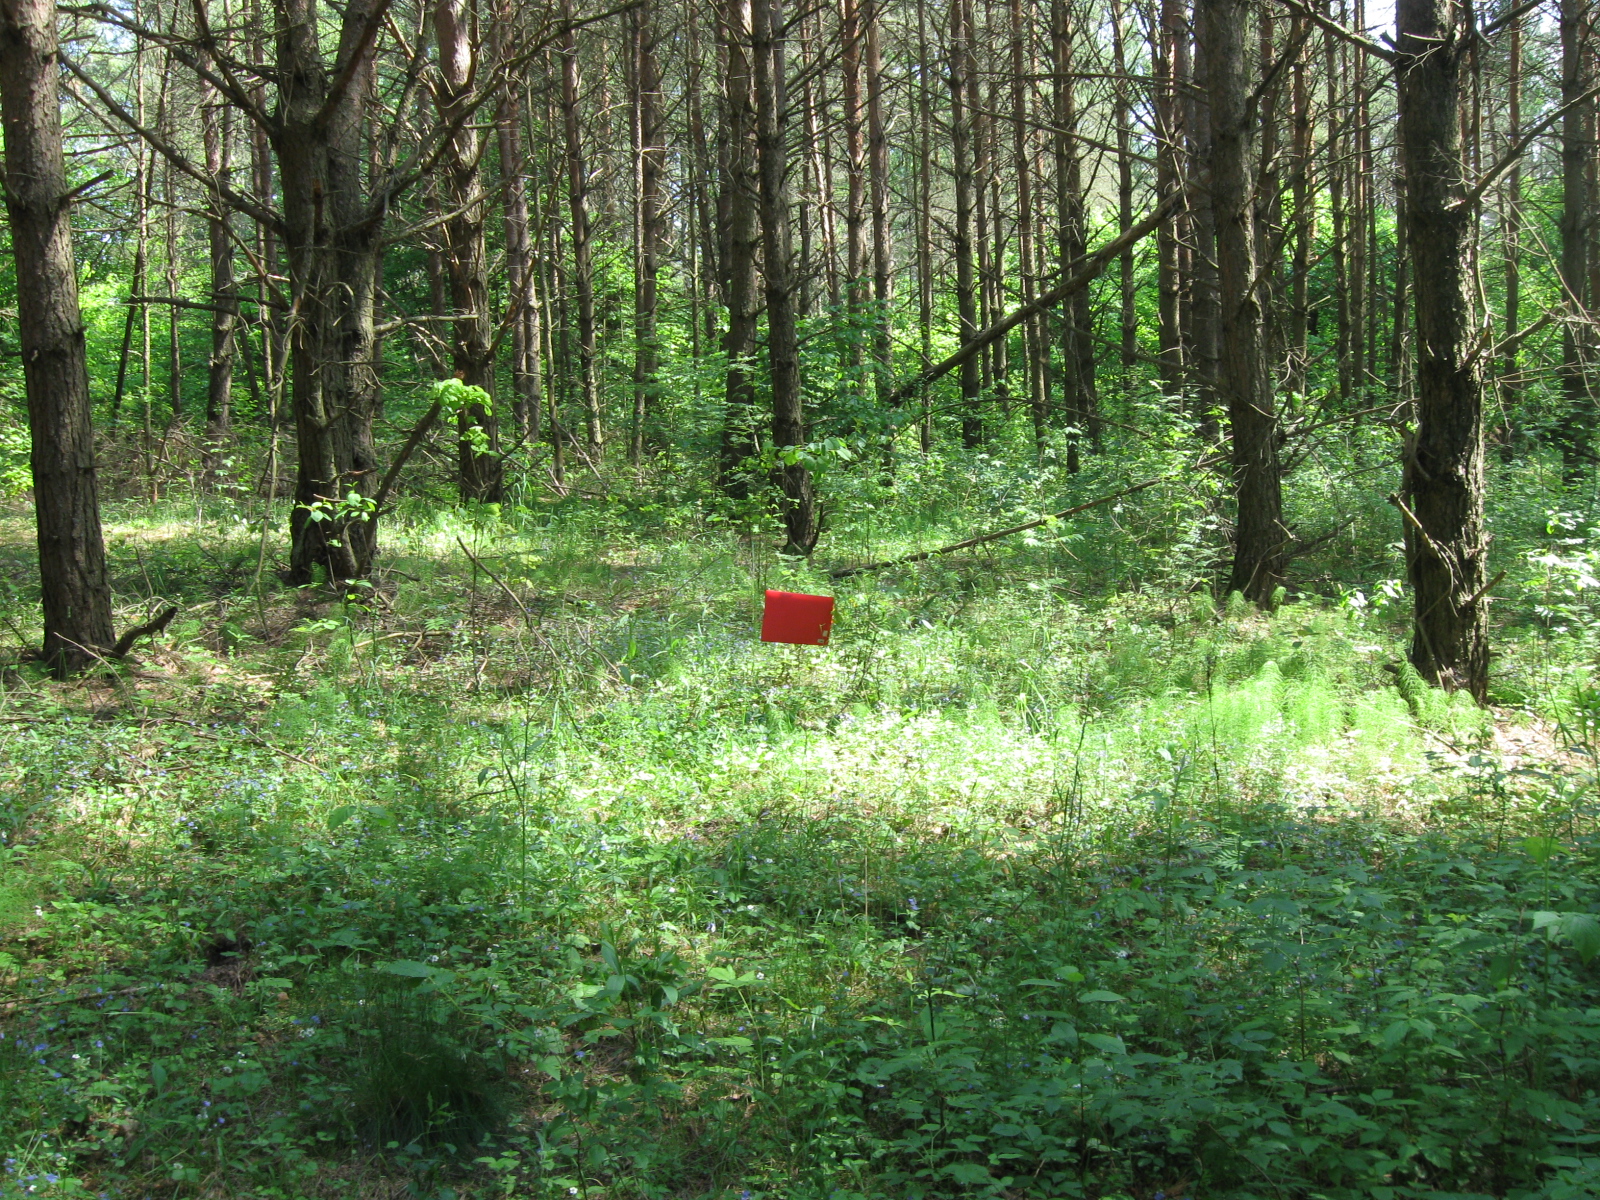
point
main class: Woodland
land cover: Pine dominated coniferous woodland
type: hemiboreal forest and nemoral coniferous forest and mixed broadleaved-coniferous forest
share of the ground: > 75 %
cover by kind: coniferous forest trees 85 %, broadleaved forest trees 10 %, herbaceous plants 5 %
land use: Forestry
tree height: > 5 m
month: June
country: LT
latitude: 54.2012
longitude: 23.7462
